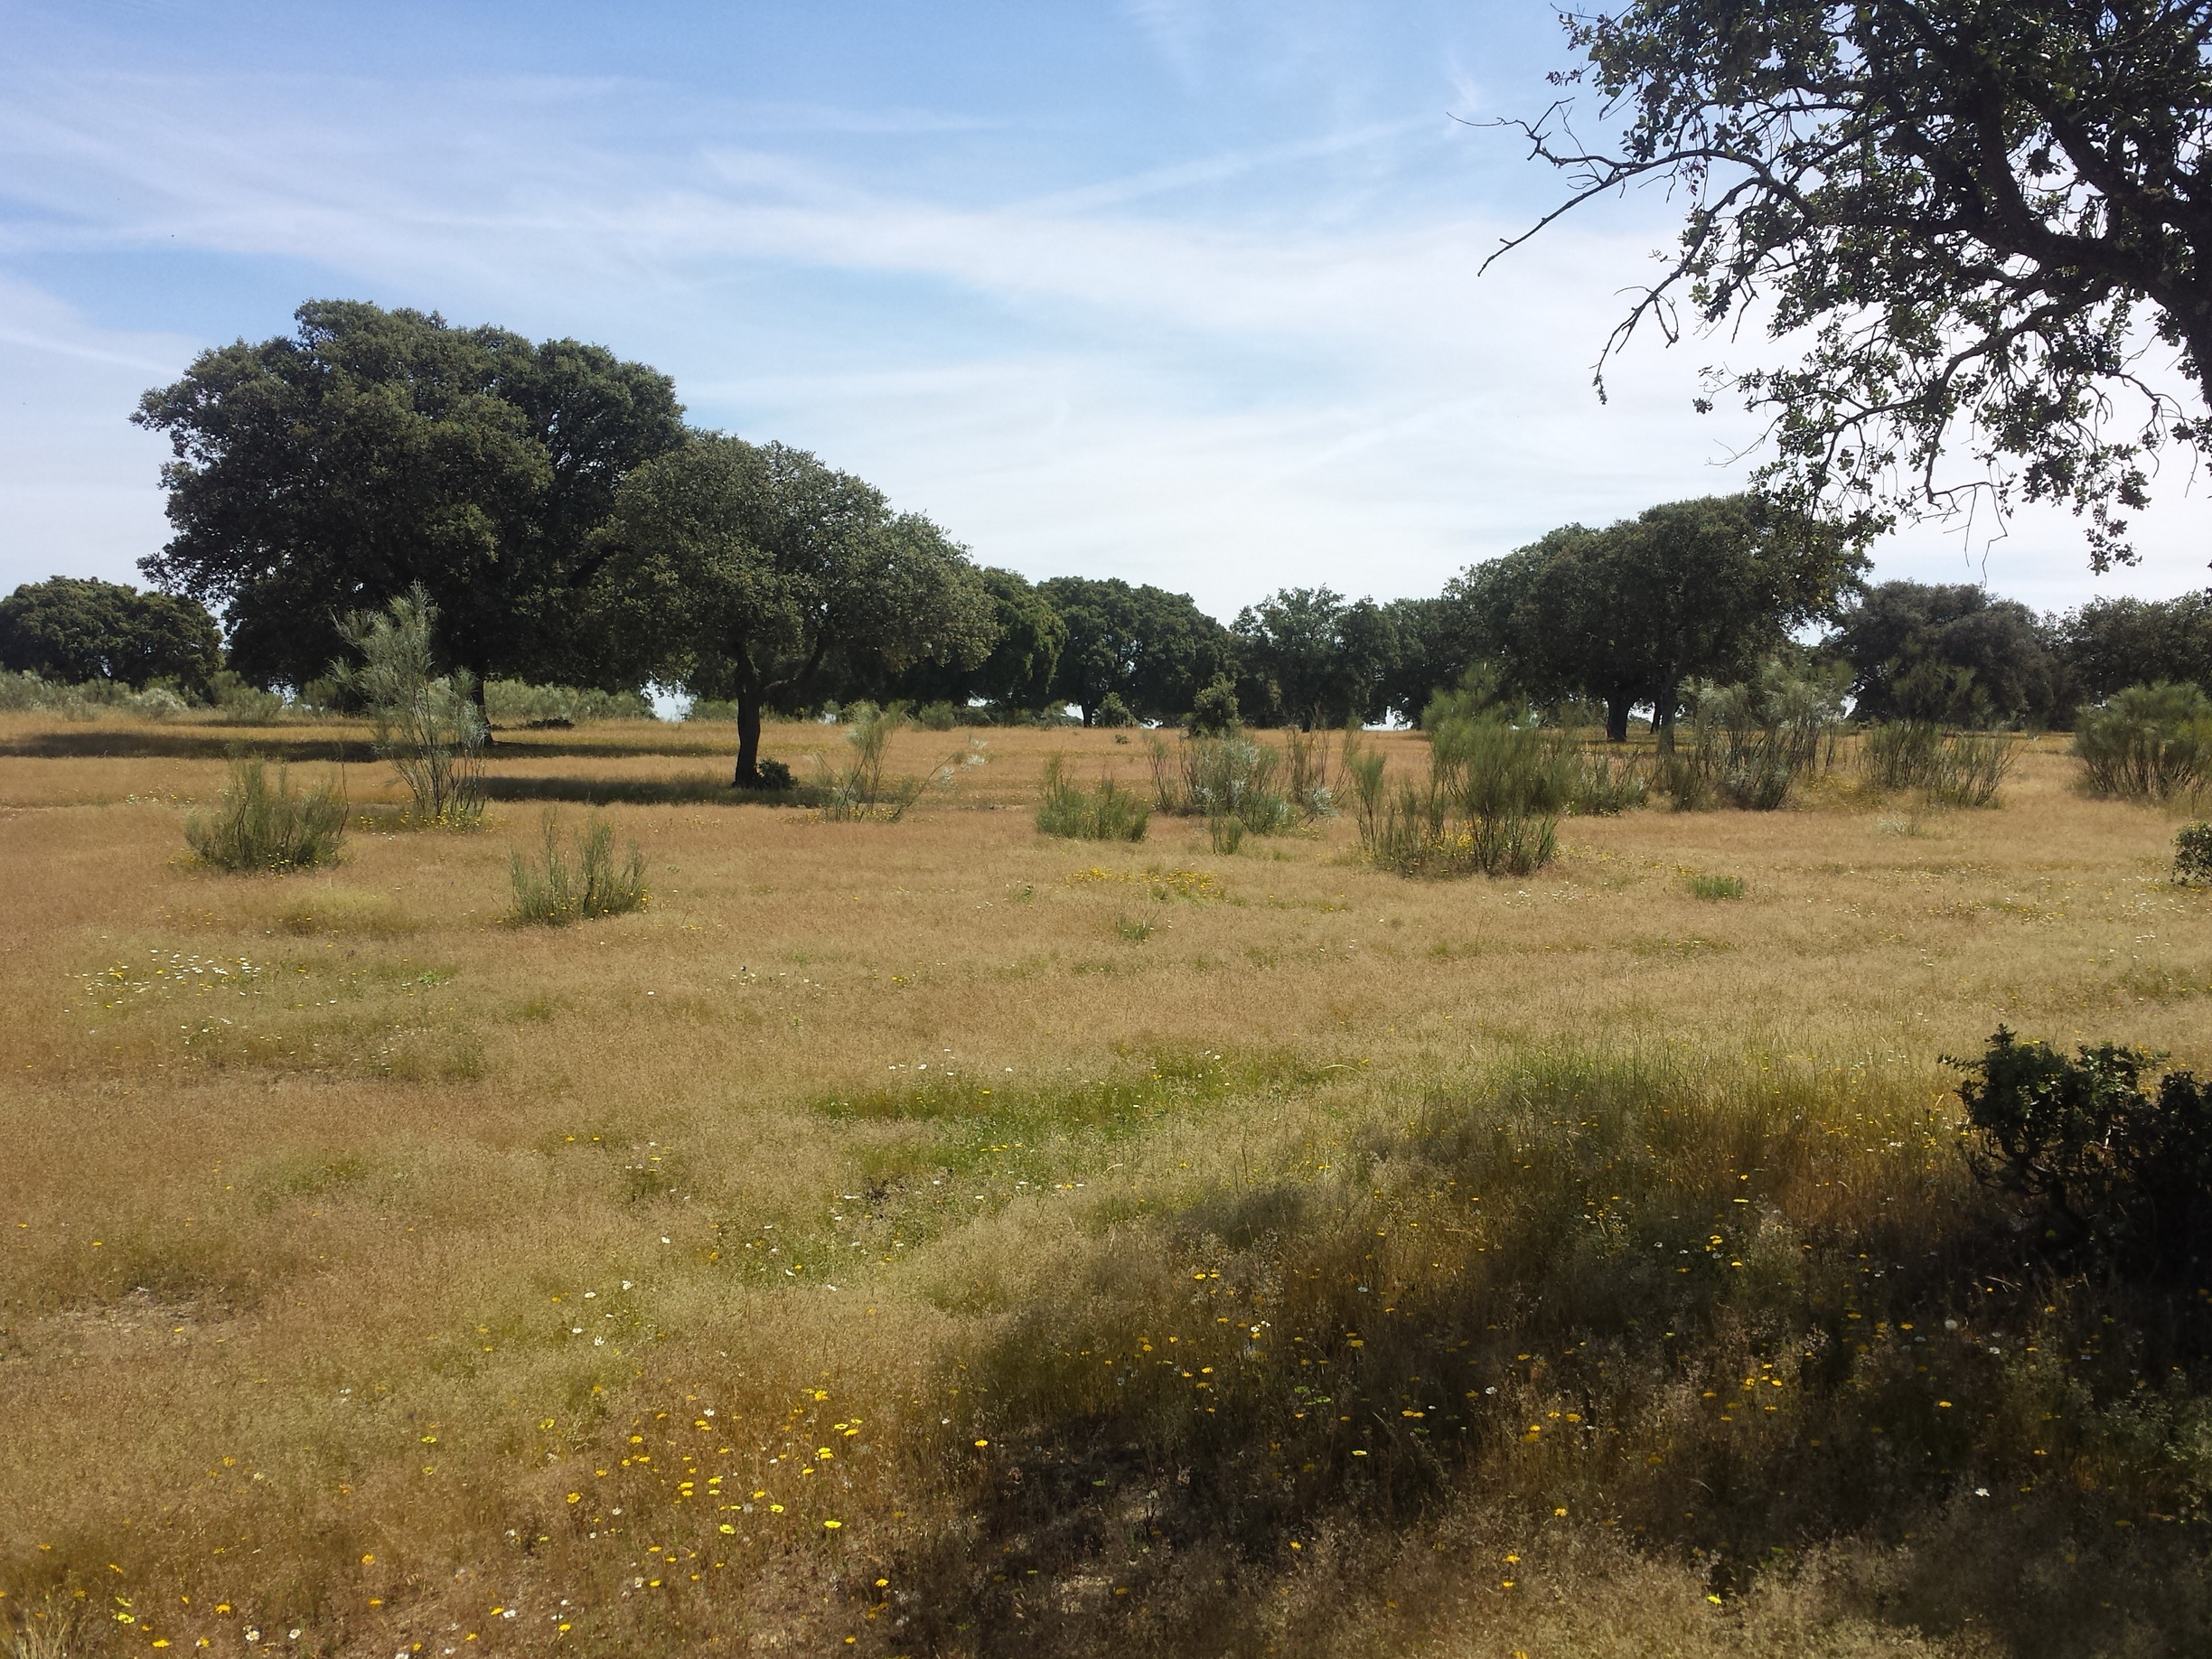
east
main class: Woodland
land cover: Broadleaved woodland
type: broadleaved evergreen forest
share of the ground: 10 - 25 %
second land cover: Grassland without tree/shrub cover
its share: > 75 %
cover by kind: herbaceous plants 85 %, broadleaved forest trees 15 %
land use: Forestry
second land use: Agriculture (excluding fallow land and kitchen gardens)
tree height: > 5 m
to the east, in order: Broadleaved woodland; Grassland without tree/shrub cover; Tracks; Broadleaved woodland
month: May
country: ES
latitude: 39.5667
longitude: -7.0911
